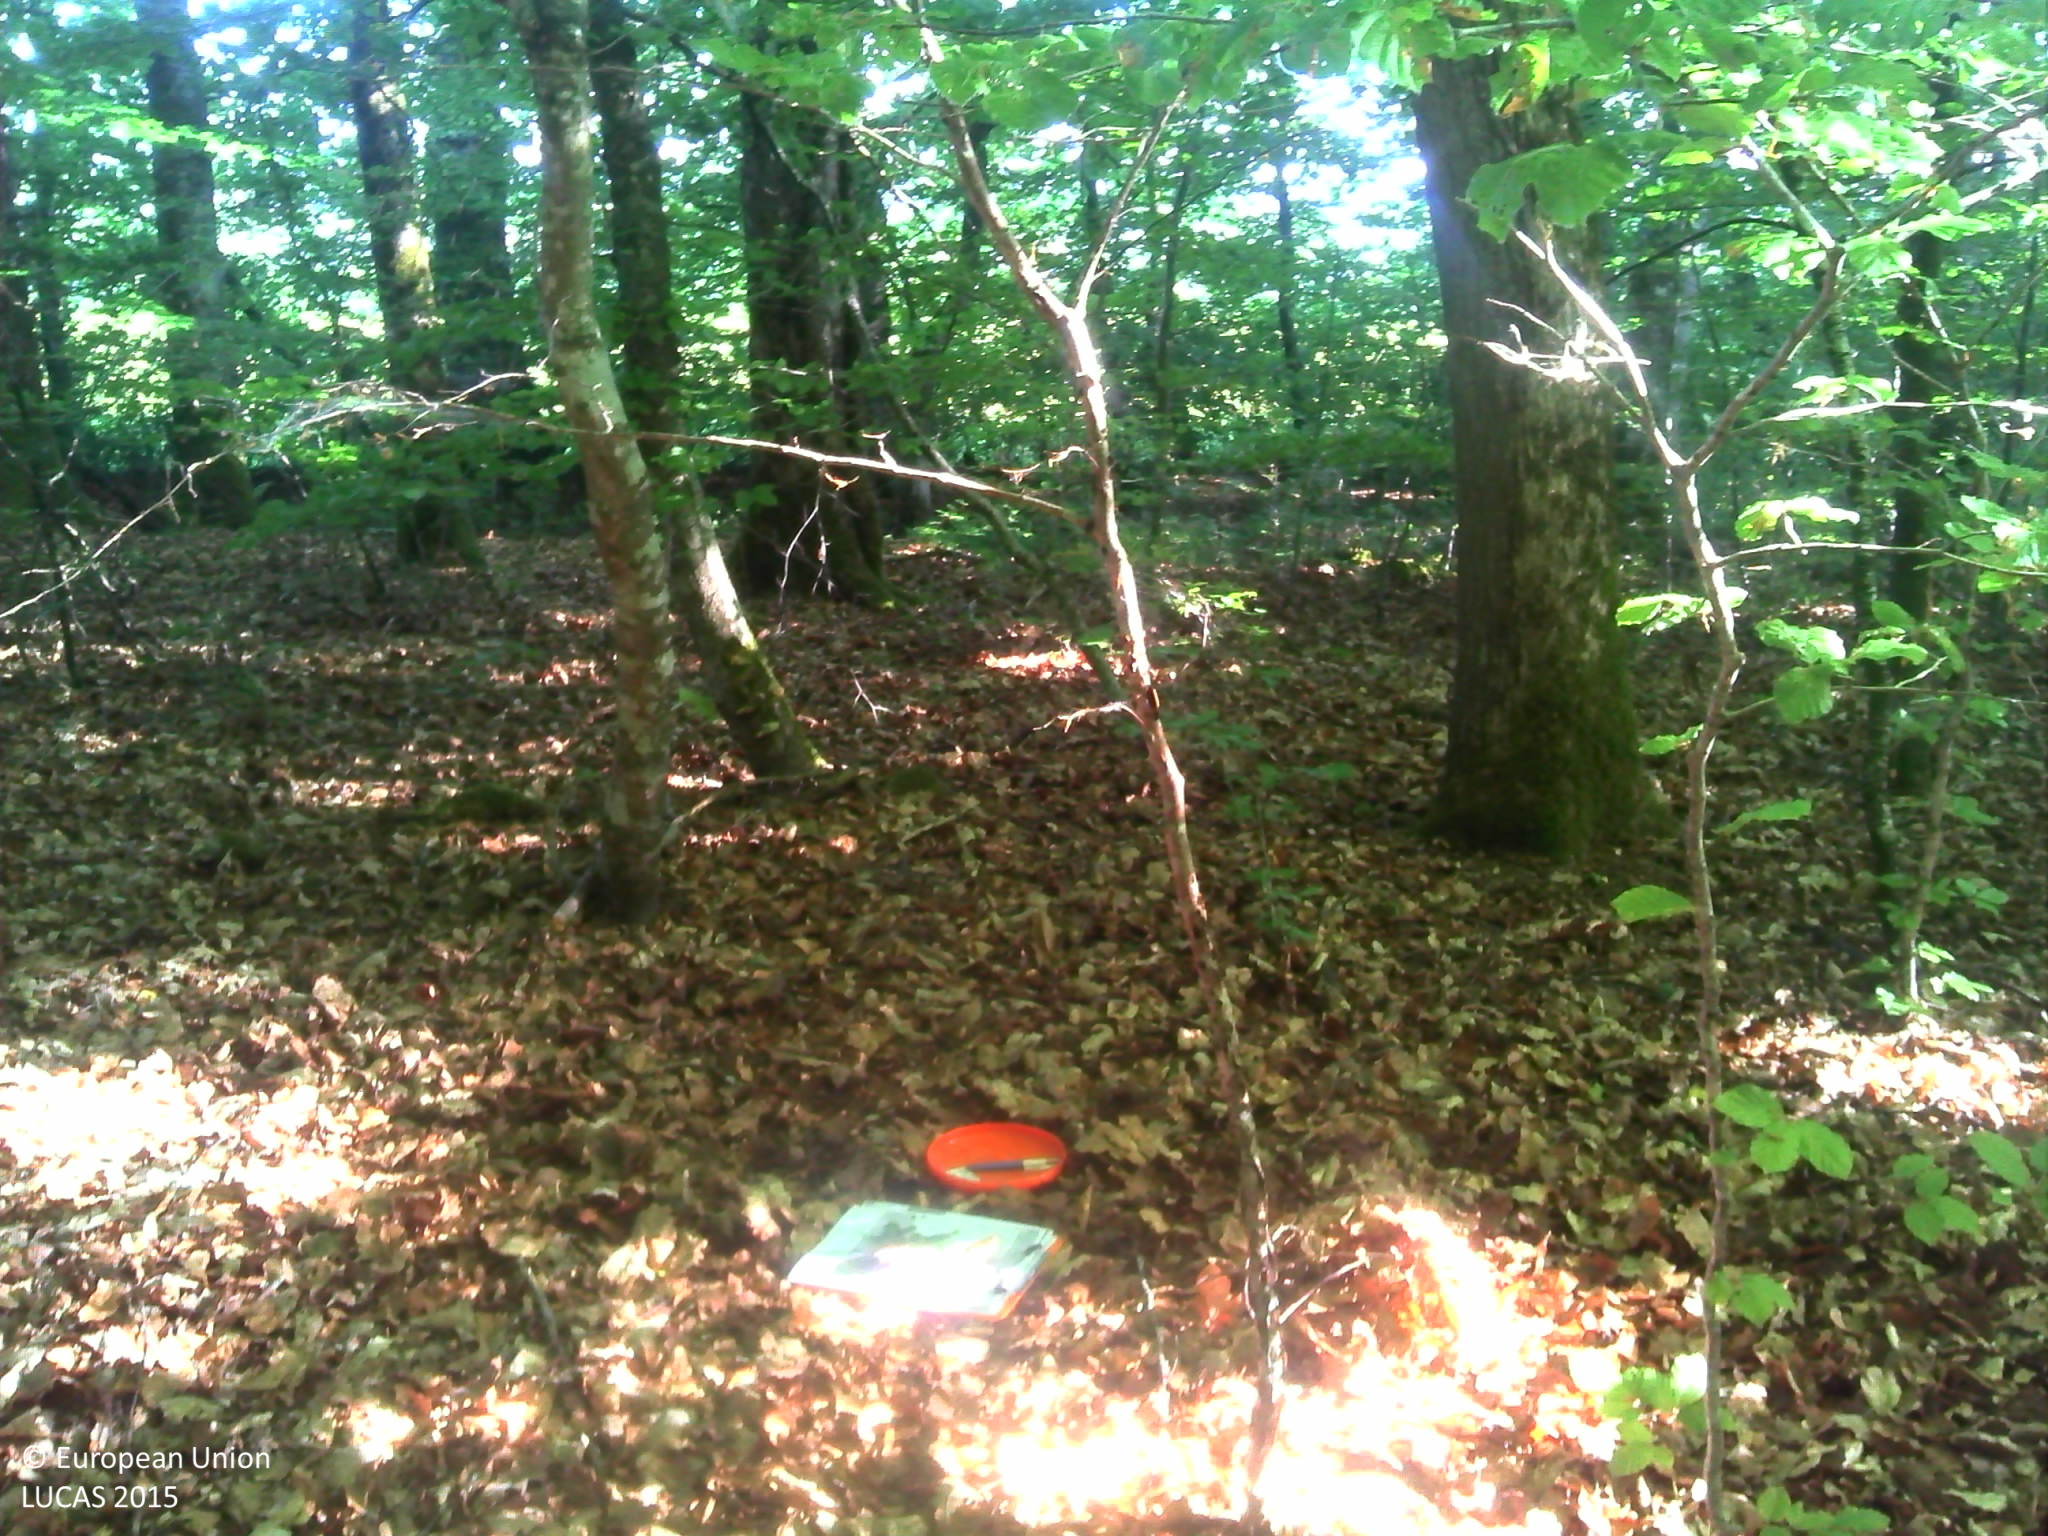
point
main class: Woodland
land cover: Broadleaved woodland
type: acidophilous oak and oak-birch forest
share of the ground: > 75 %
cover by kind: broadleaved forest trees 95 %, herbaceous plants 5 %
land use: Forestry
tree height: > 5 m
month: May
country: LU
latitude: 49.8178
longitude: 6.2886
